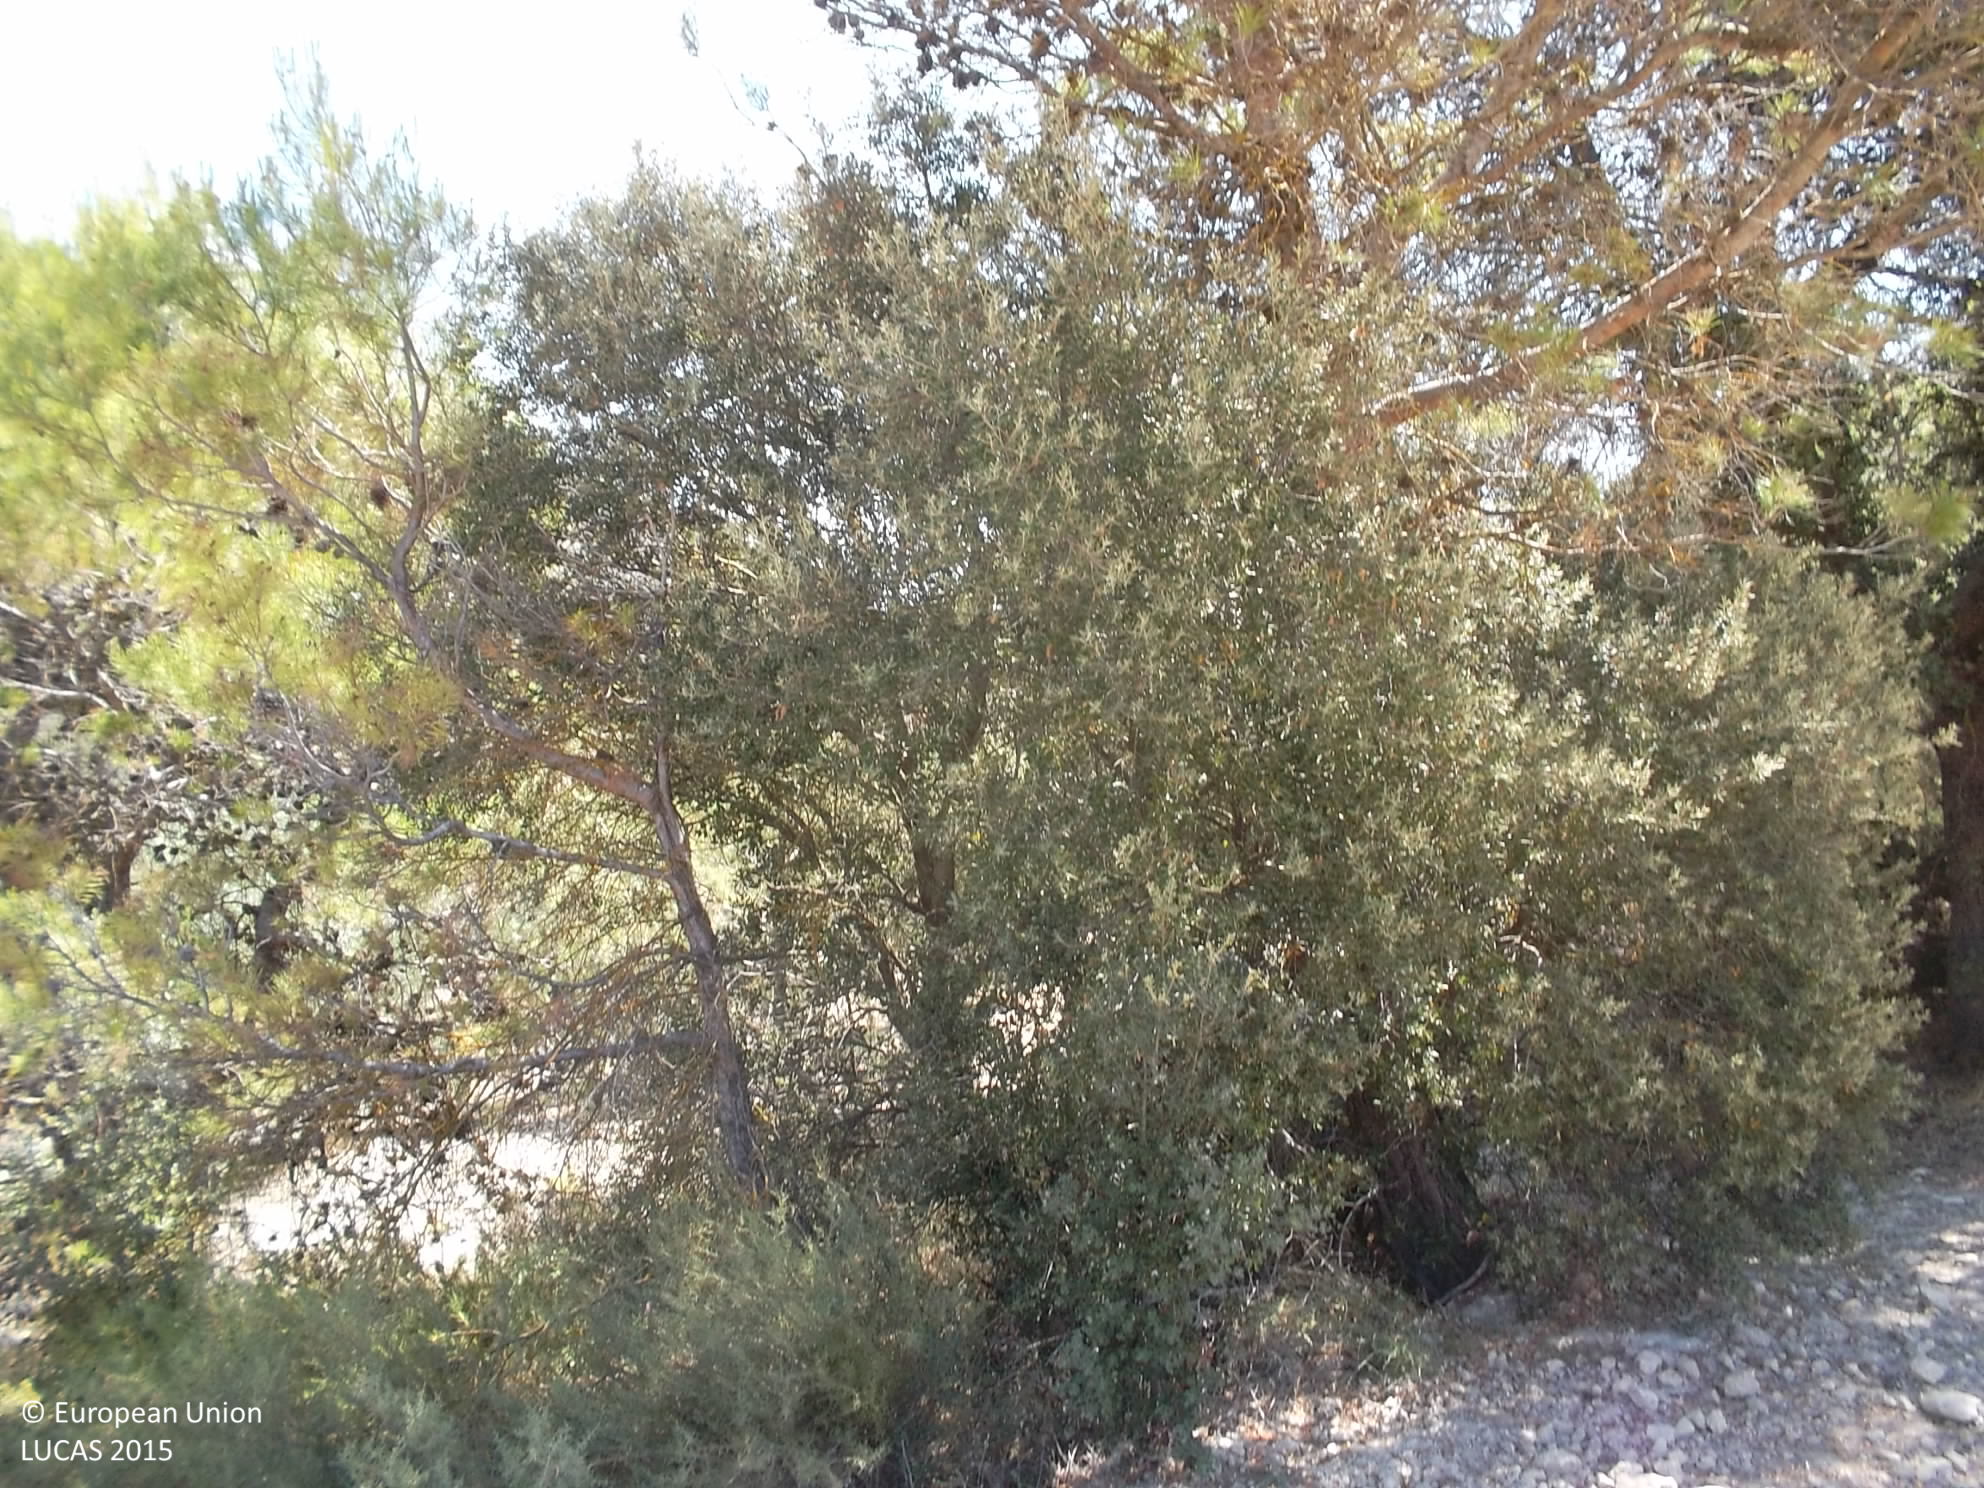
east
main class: Cropland
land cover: Olive groves
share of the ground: 10 - 25 %
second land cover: Other bare soil
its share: > 75 %
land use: Agriculture (excluding fallow land and kitchen gardens)
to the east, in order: Olive groves; Other bare soil; Pine dominated mixed woodland; Grass margins; Rock outcrops; Nuts trees; Broadleaved woodland; Rock outcrops; Broadleaved woodland; Olive groves
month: June
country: ES
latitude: 37.6659
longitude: -3.3378
